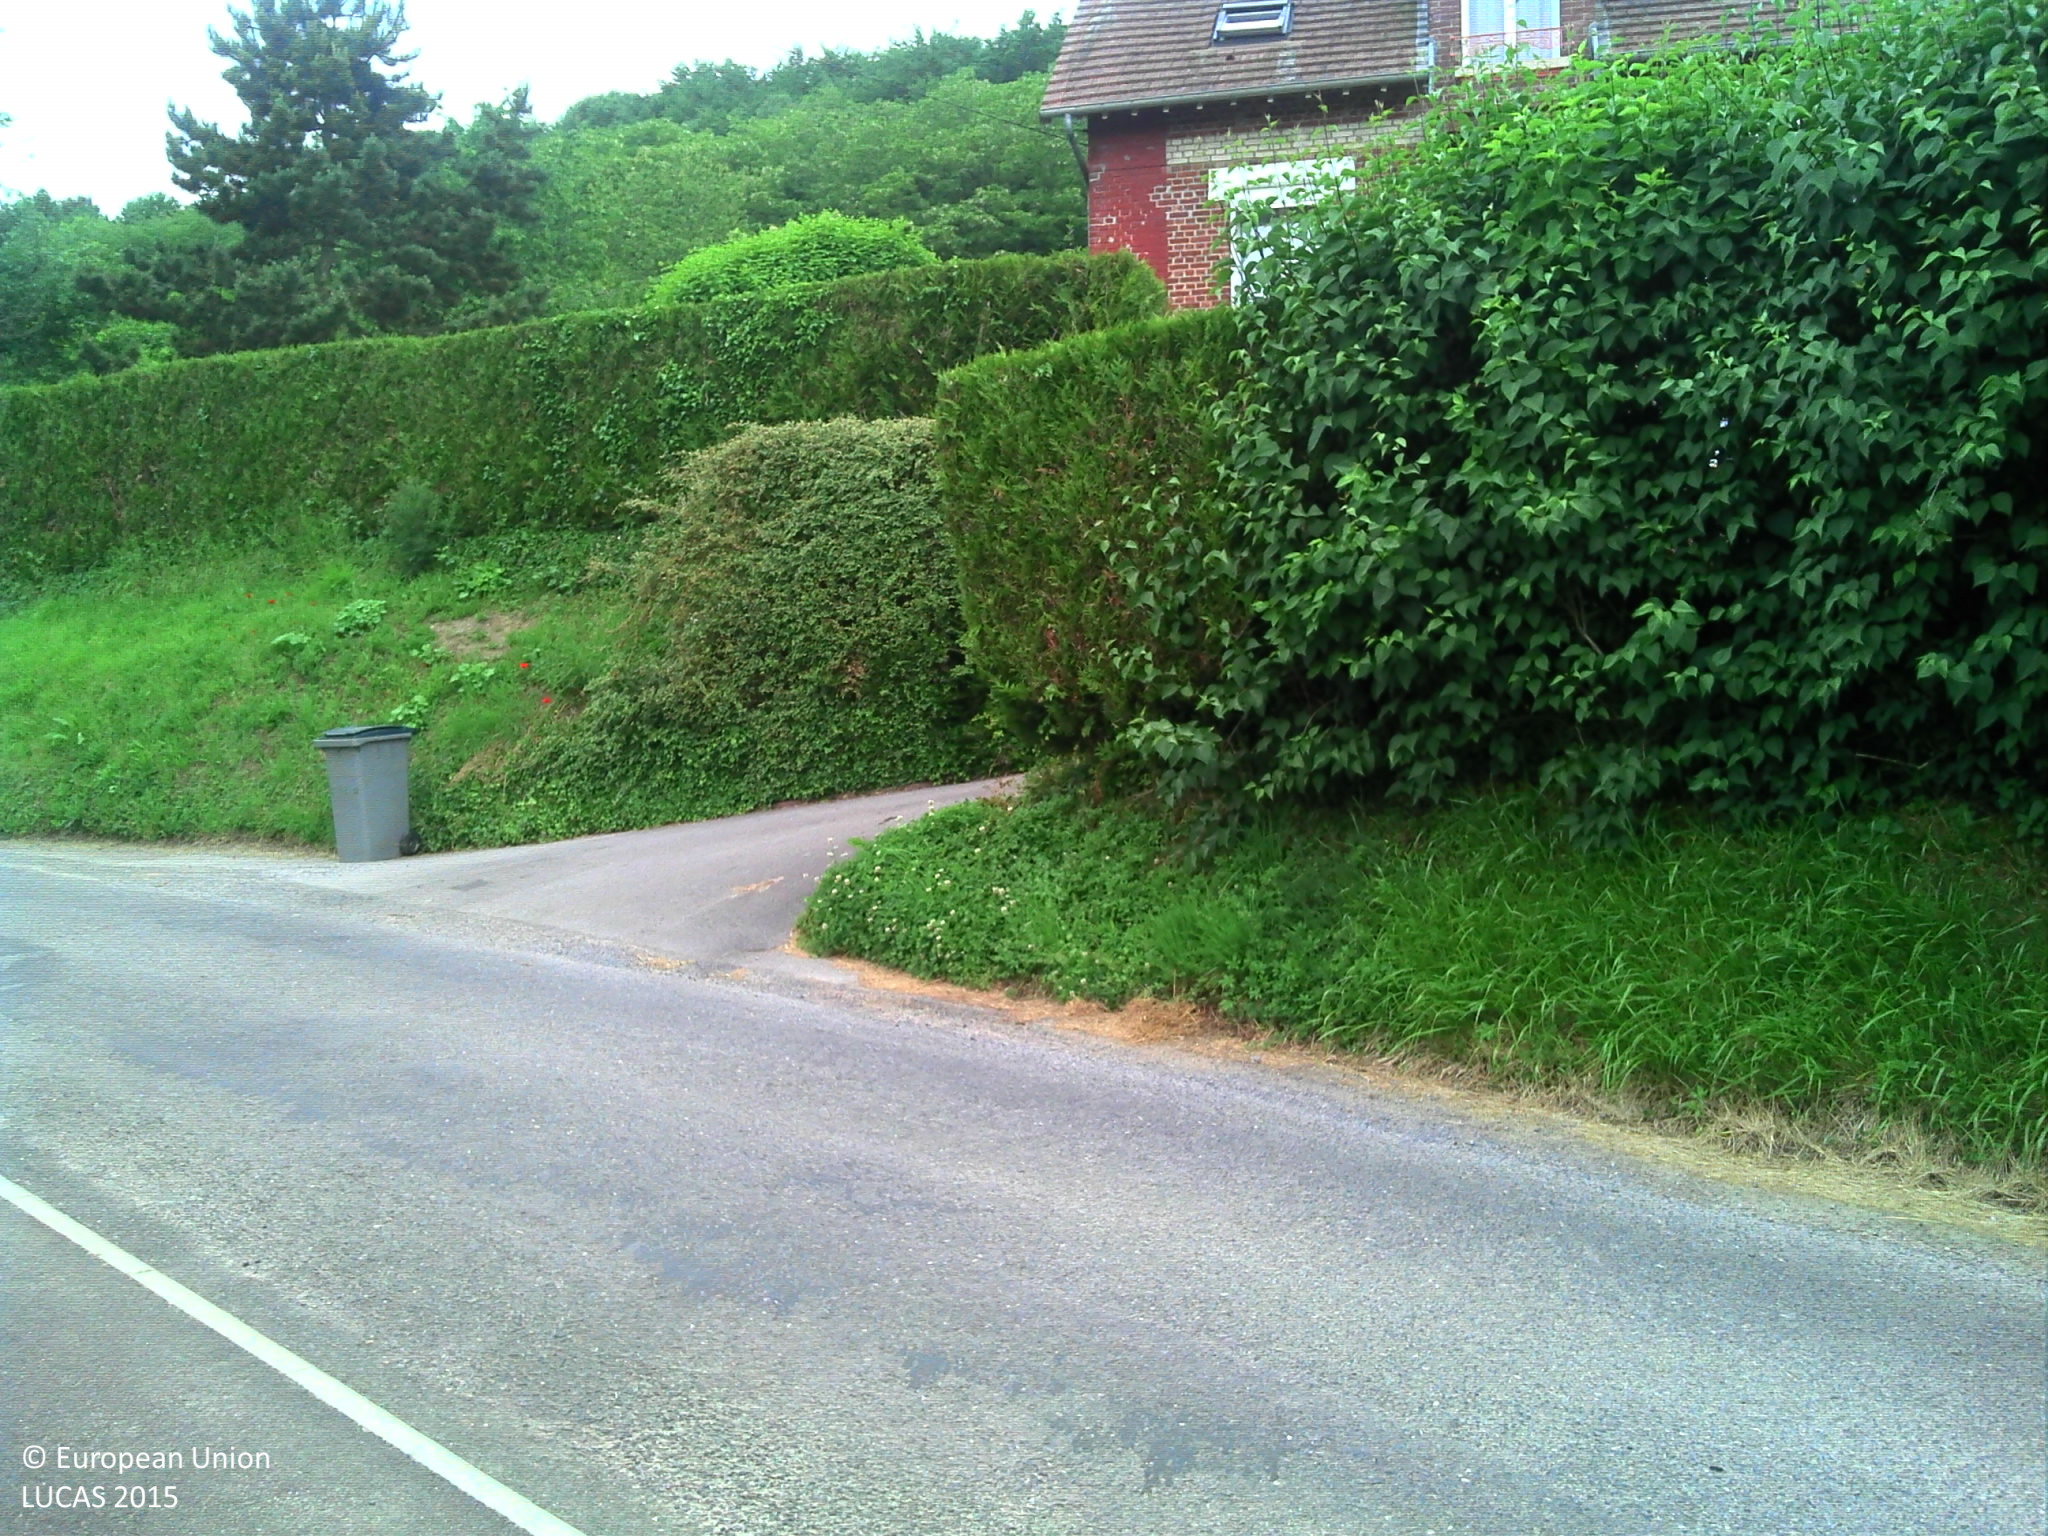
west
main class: Grassland
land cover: Grassland without tree/shrub cover
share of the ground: > 75 %
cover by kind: herbaceous plants 100 %
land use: Semi-natural and natural areas not in use
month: June
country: FR
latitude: 49.5158
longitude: 3.2651
